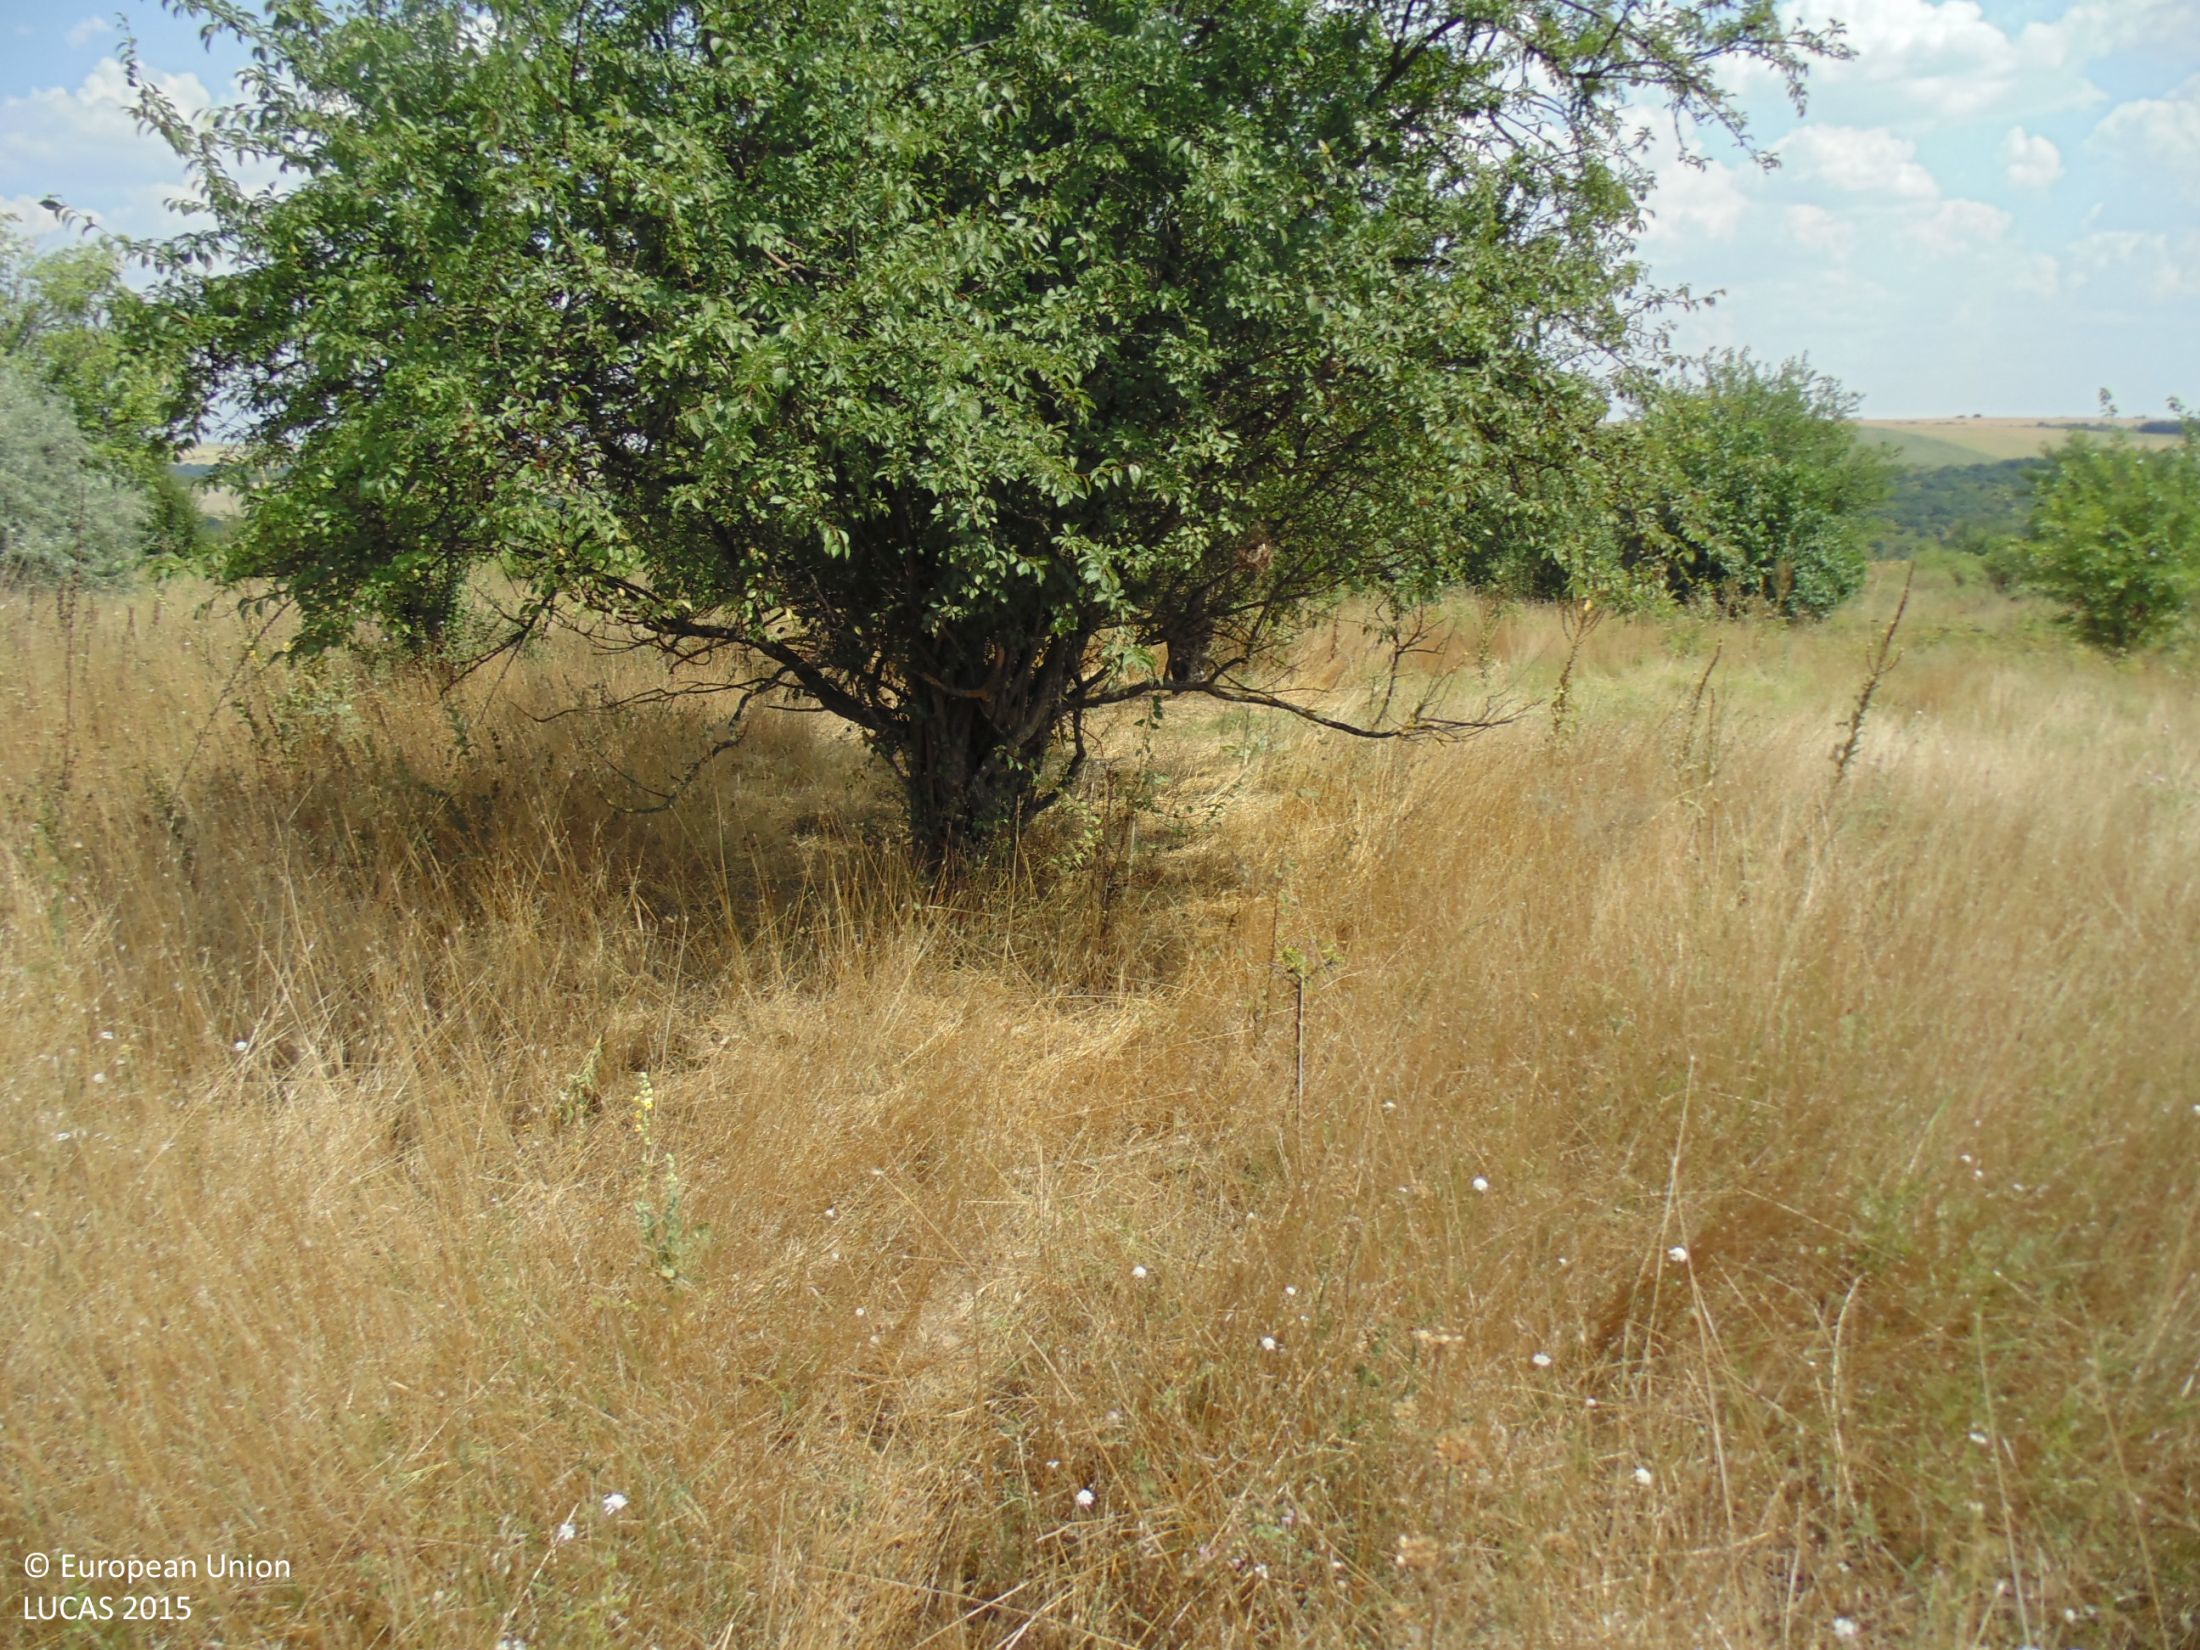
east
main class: Grassland
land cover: Grassland with sparse tree/shrub cover
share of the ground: > 75 %
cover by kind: herbaceous plants 90 %, broadleaved forest trees 5 %, shrubs 5 %
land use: Agriculture (excluding fallow land and kitchen gardens)
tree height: < 5 m
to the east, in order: Grassland with sparse tree/shrub cover; Maize
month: August
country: BG
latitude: 44.0043
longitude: 27.6391
